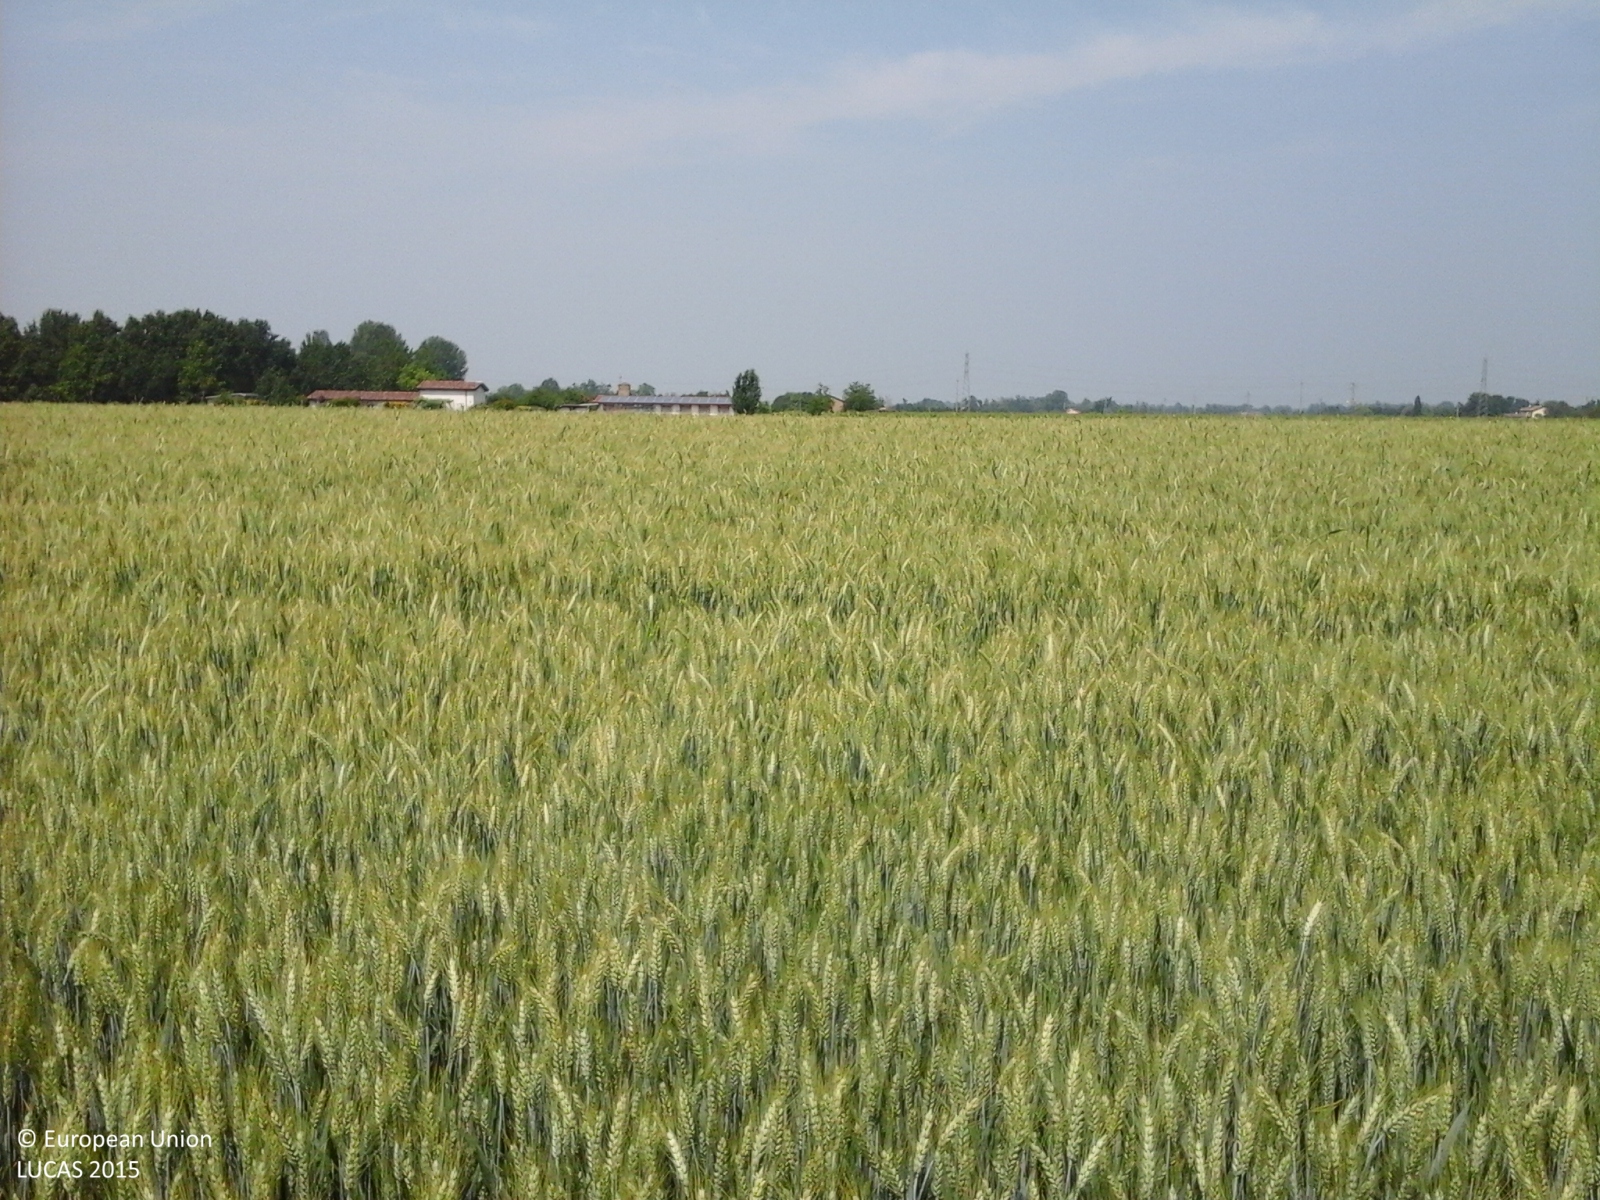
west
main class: Cropland
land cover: Common wheat
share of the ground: > 75 %
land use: Agriculture (excluding fallow land and kitchen gardens)
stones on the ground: < 10 %
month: May
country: IT
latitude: 44.7435
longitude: 10.8948
